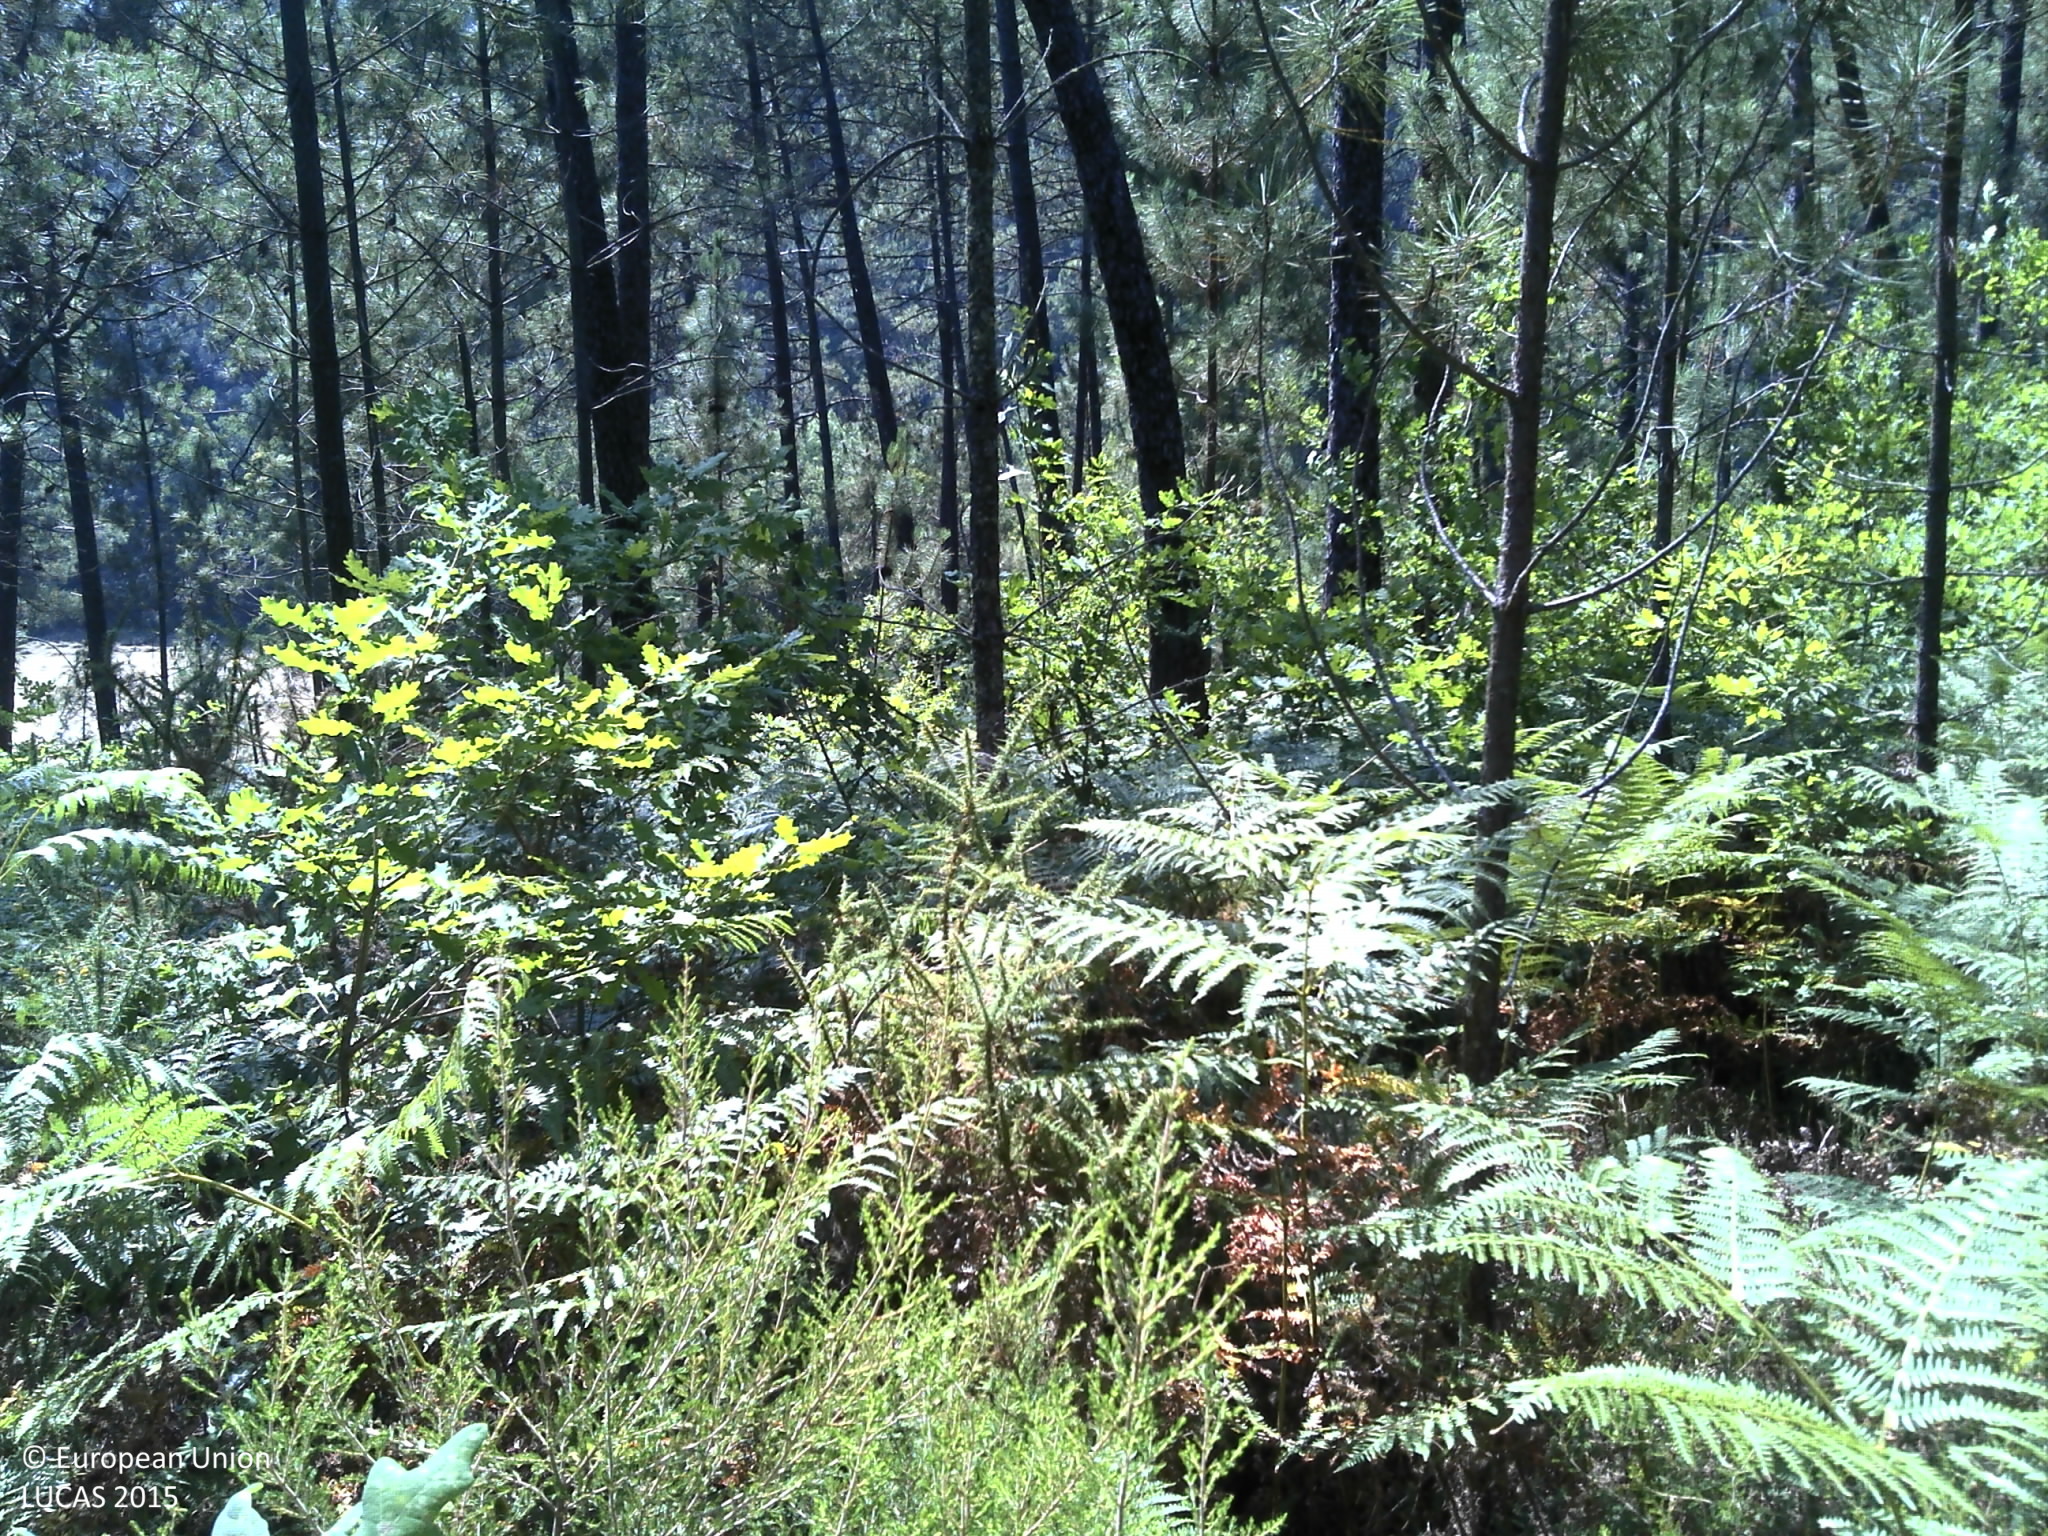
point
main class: Woodland
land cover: Pine dominated coniferous woodland
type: coniferous forest of the mediterranean region
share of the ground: 10 - 25 %
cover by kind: shrubs 85 %, coniferous forest trees 15 %
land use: Forestry
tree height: > 5 m
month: July
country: PT
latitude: 40.9143
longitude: -7.9025
